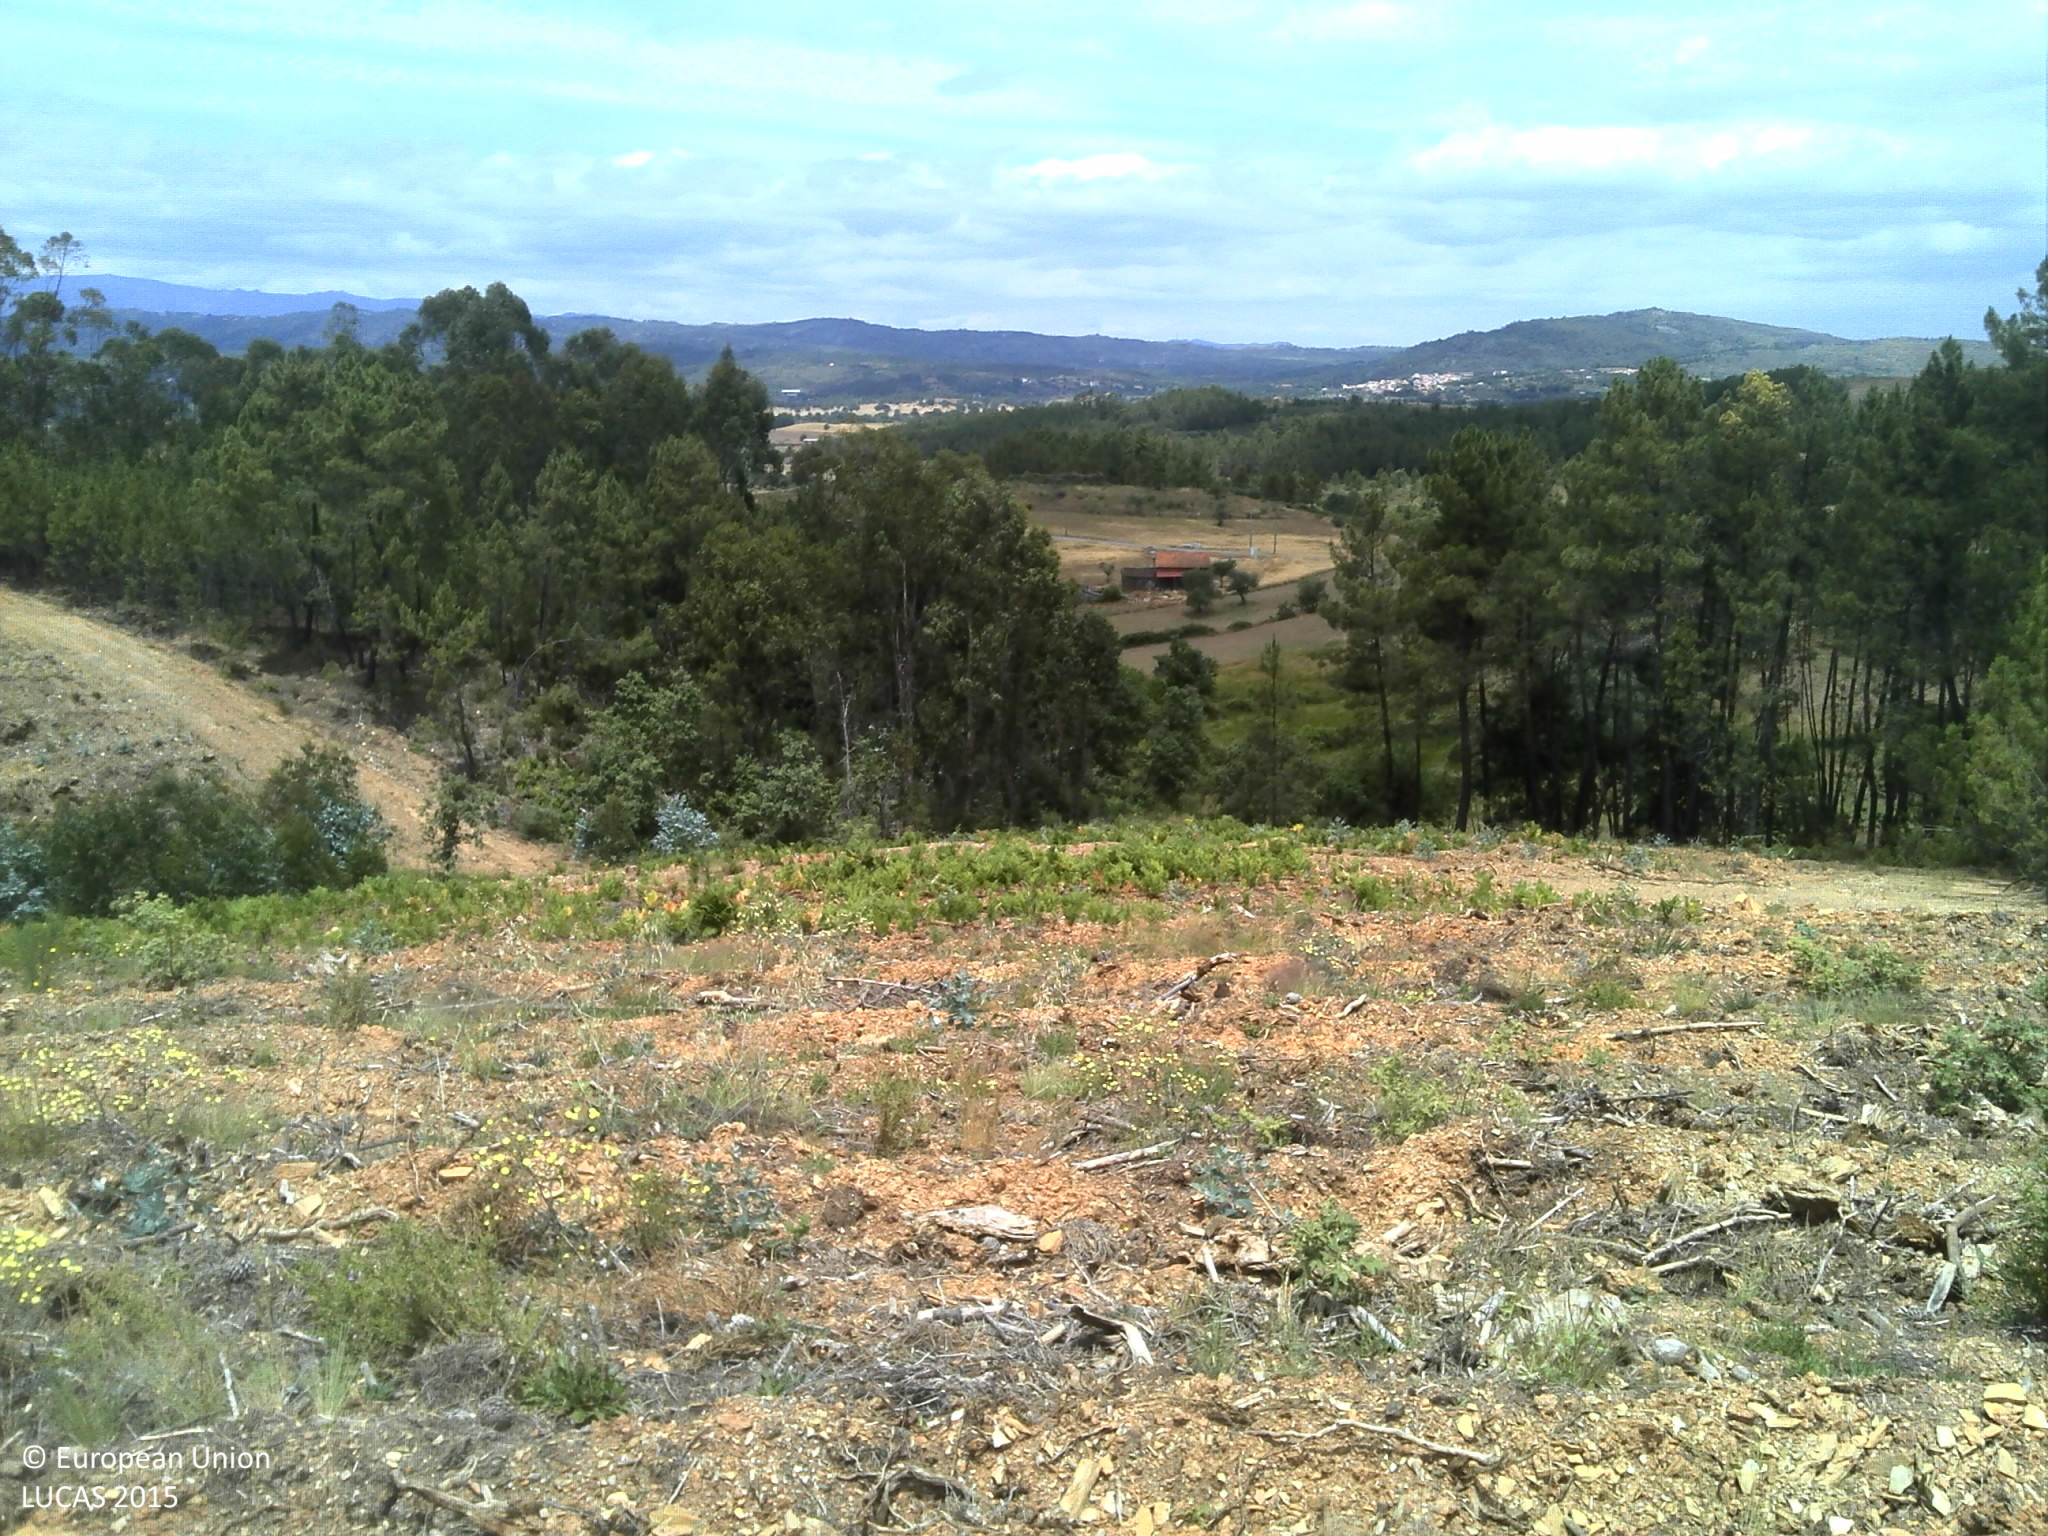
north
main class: Woodland
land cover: Broadleaved woodland
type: exotic forest
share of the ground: < 10 %
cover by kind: unconsolidated bare surface 85 %, broadleaved forest trees 10 %, herbaceous plants 5 %
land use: Forestry
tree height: < 5 m
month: June
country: PT
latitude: 40.1617
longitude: -7.3731
